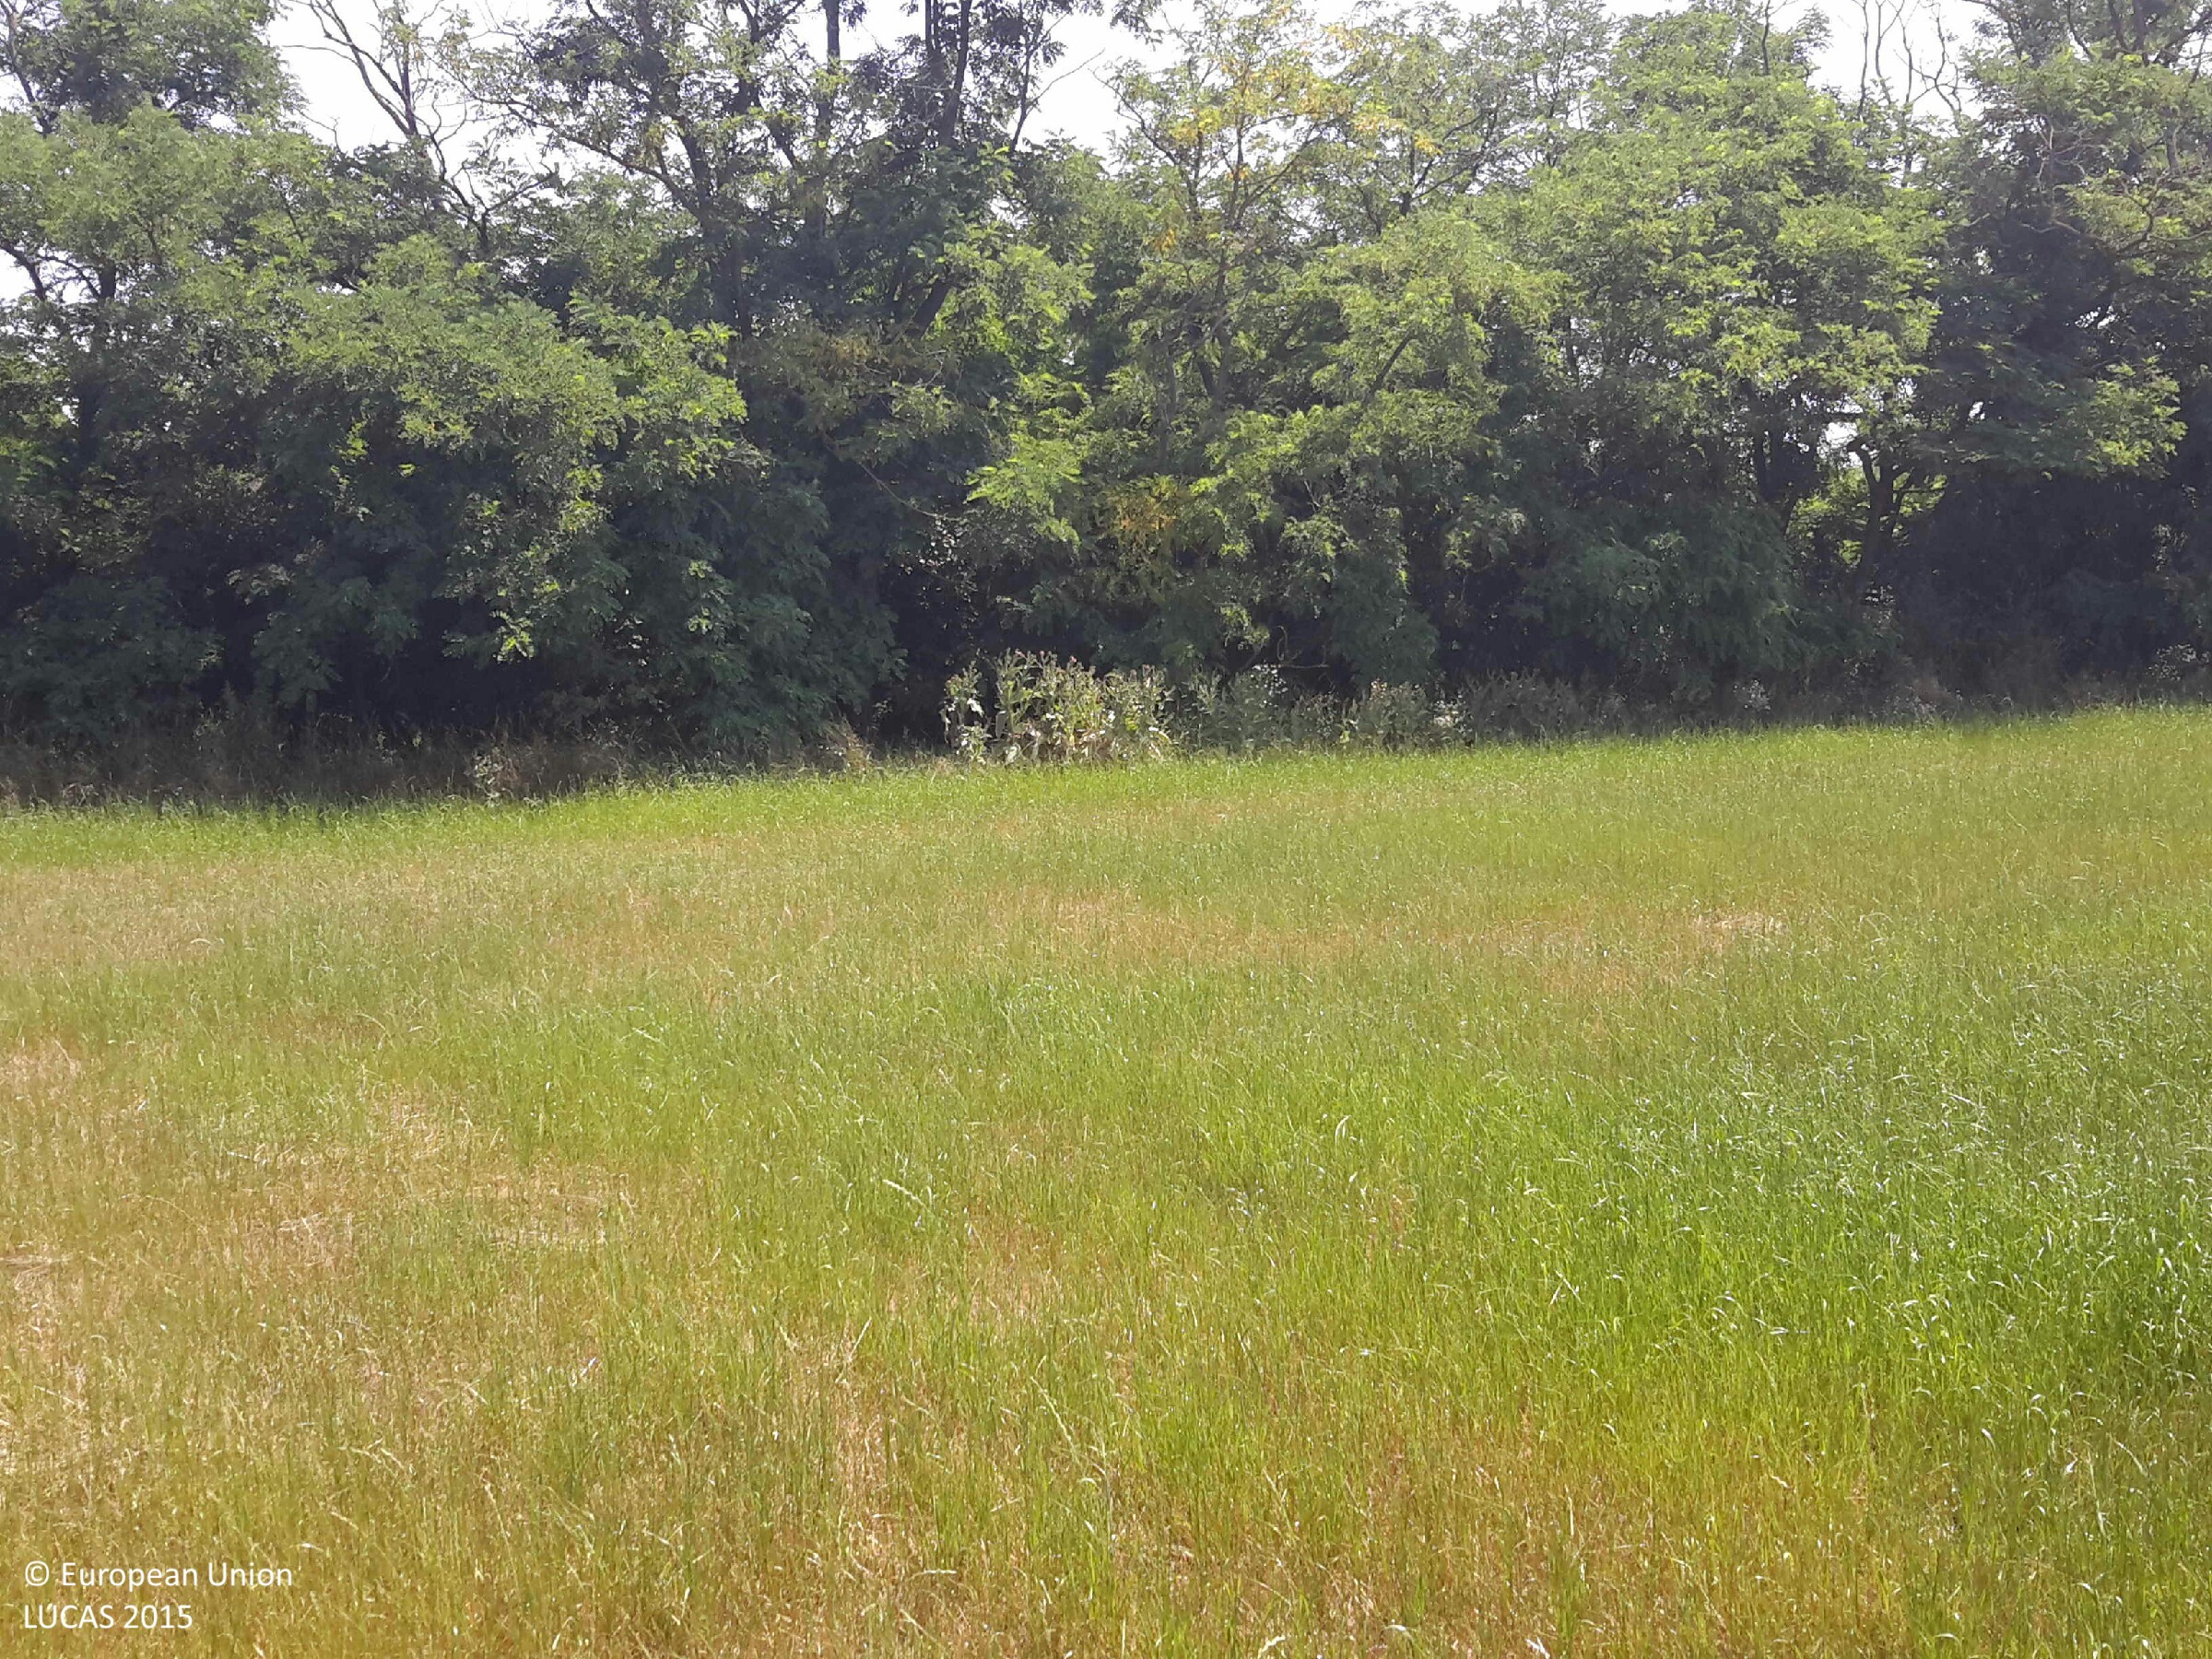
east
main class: Grassland
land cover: Grassland without tree/shrub cover
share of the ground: > 75 %
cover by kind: herbaceous plants 100 %
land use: Agriculture (excluding fallow land and kitchen gardens)
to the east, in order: Grassland without tree/shrub cover; Broadleaved woodland; Tracks; Broadleaved woodland; Maize
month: July
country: HU
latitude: 47.3113
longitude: 17.3217
